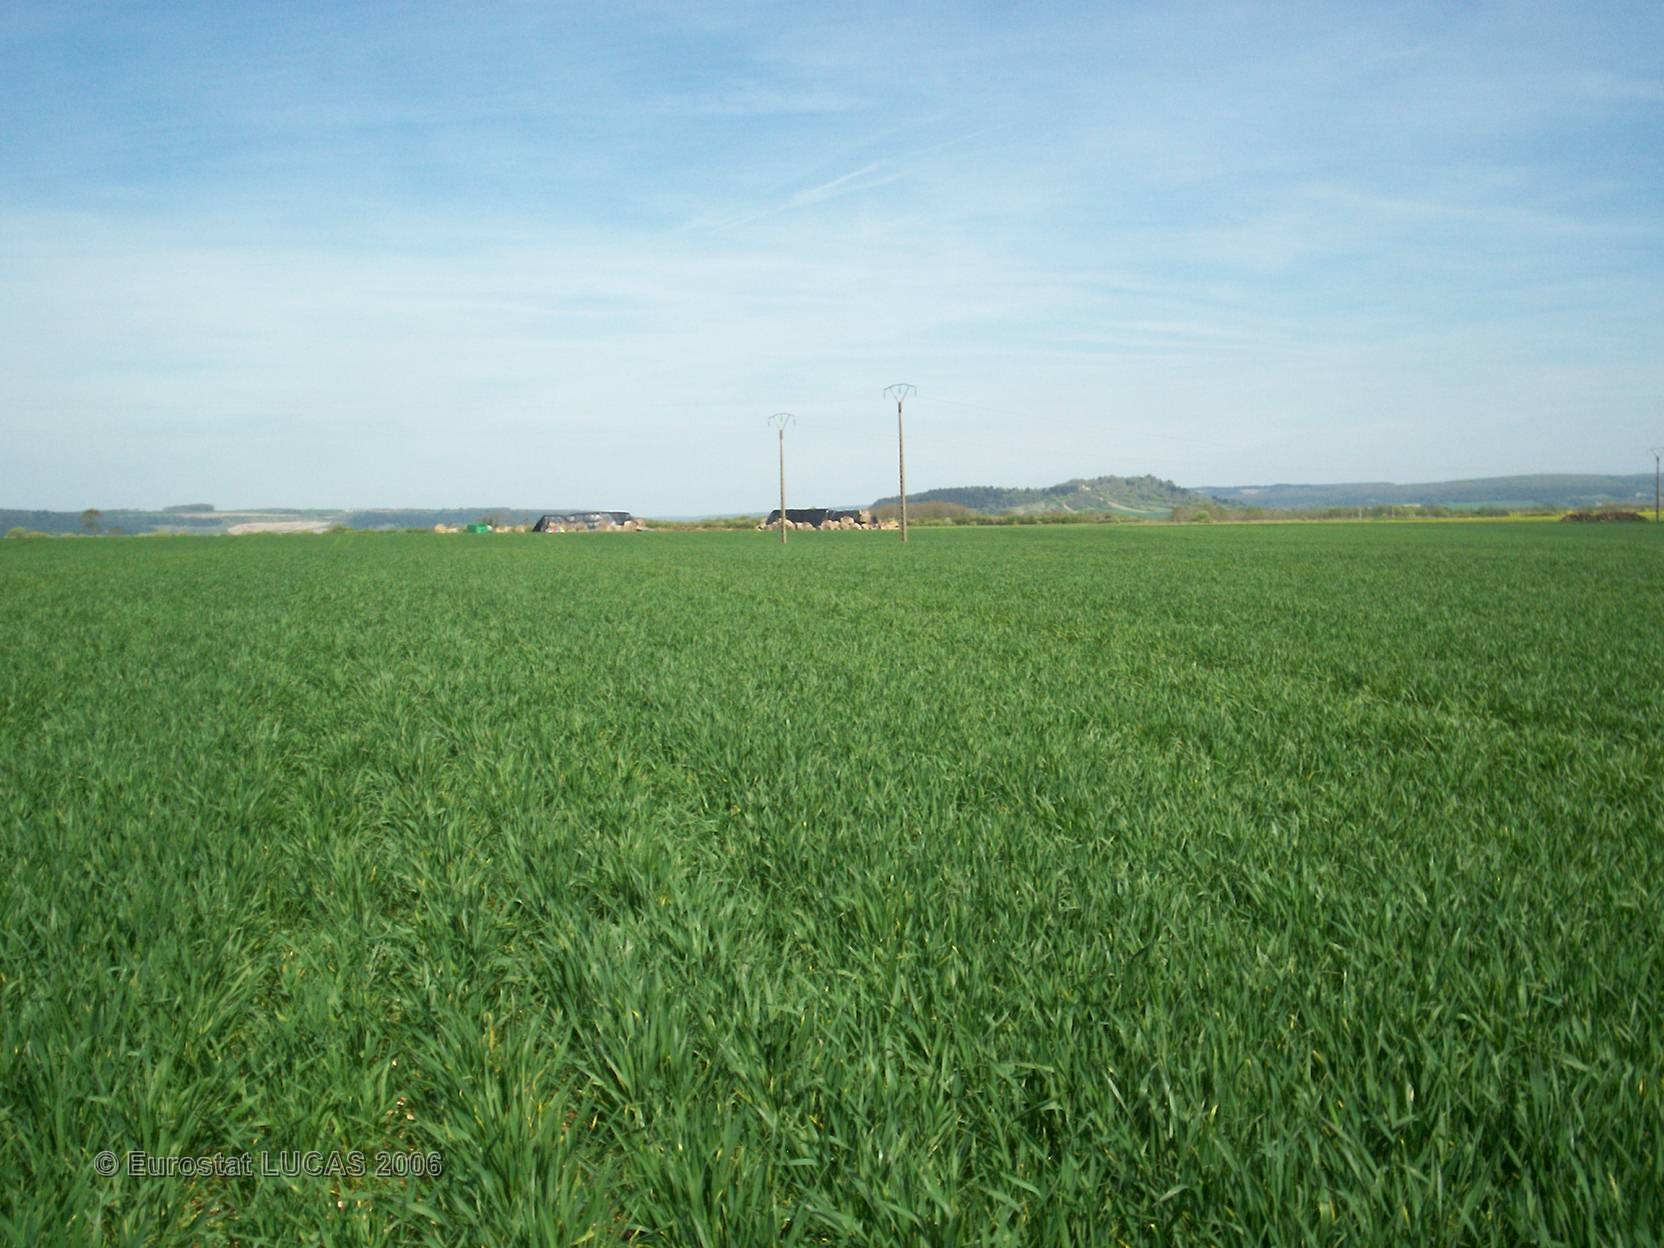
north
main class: Cropland
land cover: Common wheat
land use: Agriculture (excluding fallow land and kitchen gardens)
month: May
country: FR
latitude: 47.8713
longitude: 4.5303
